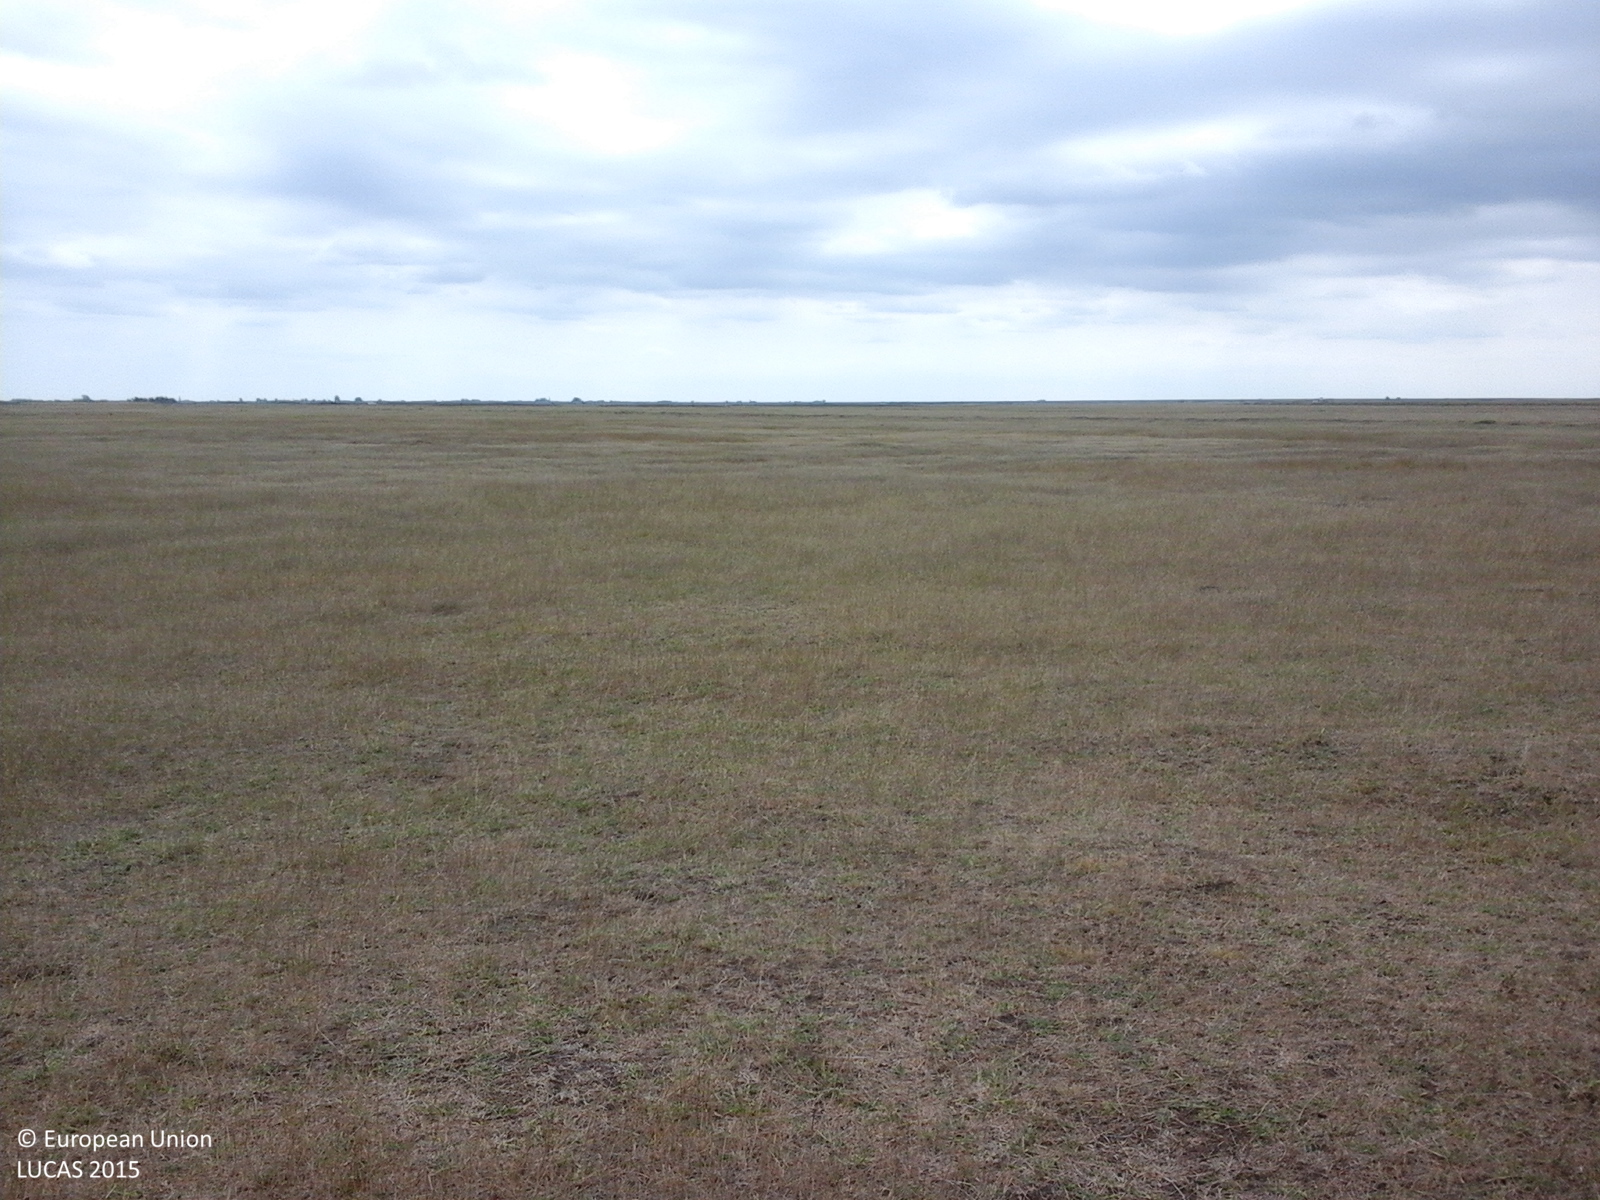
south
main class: Grassland
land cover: Grassland without tree/shrub cover
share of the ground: > 75 %
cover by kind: herbaceous plants 100 %
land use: Agriculture (excluding fallow land and kitchen gardens)
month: August
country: RO
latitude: 45.5125
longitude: 20.9708
